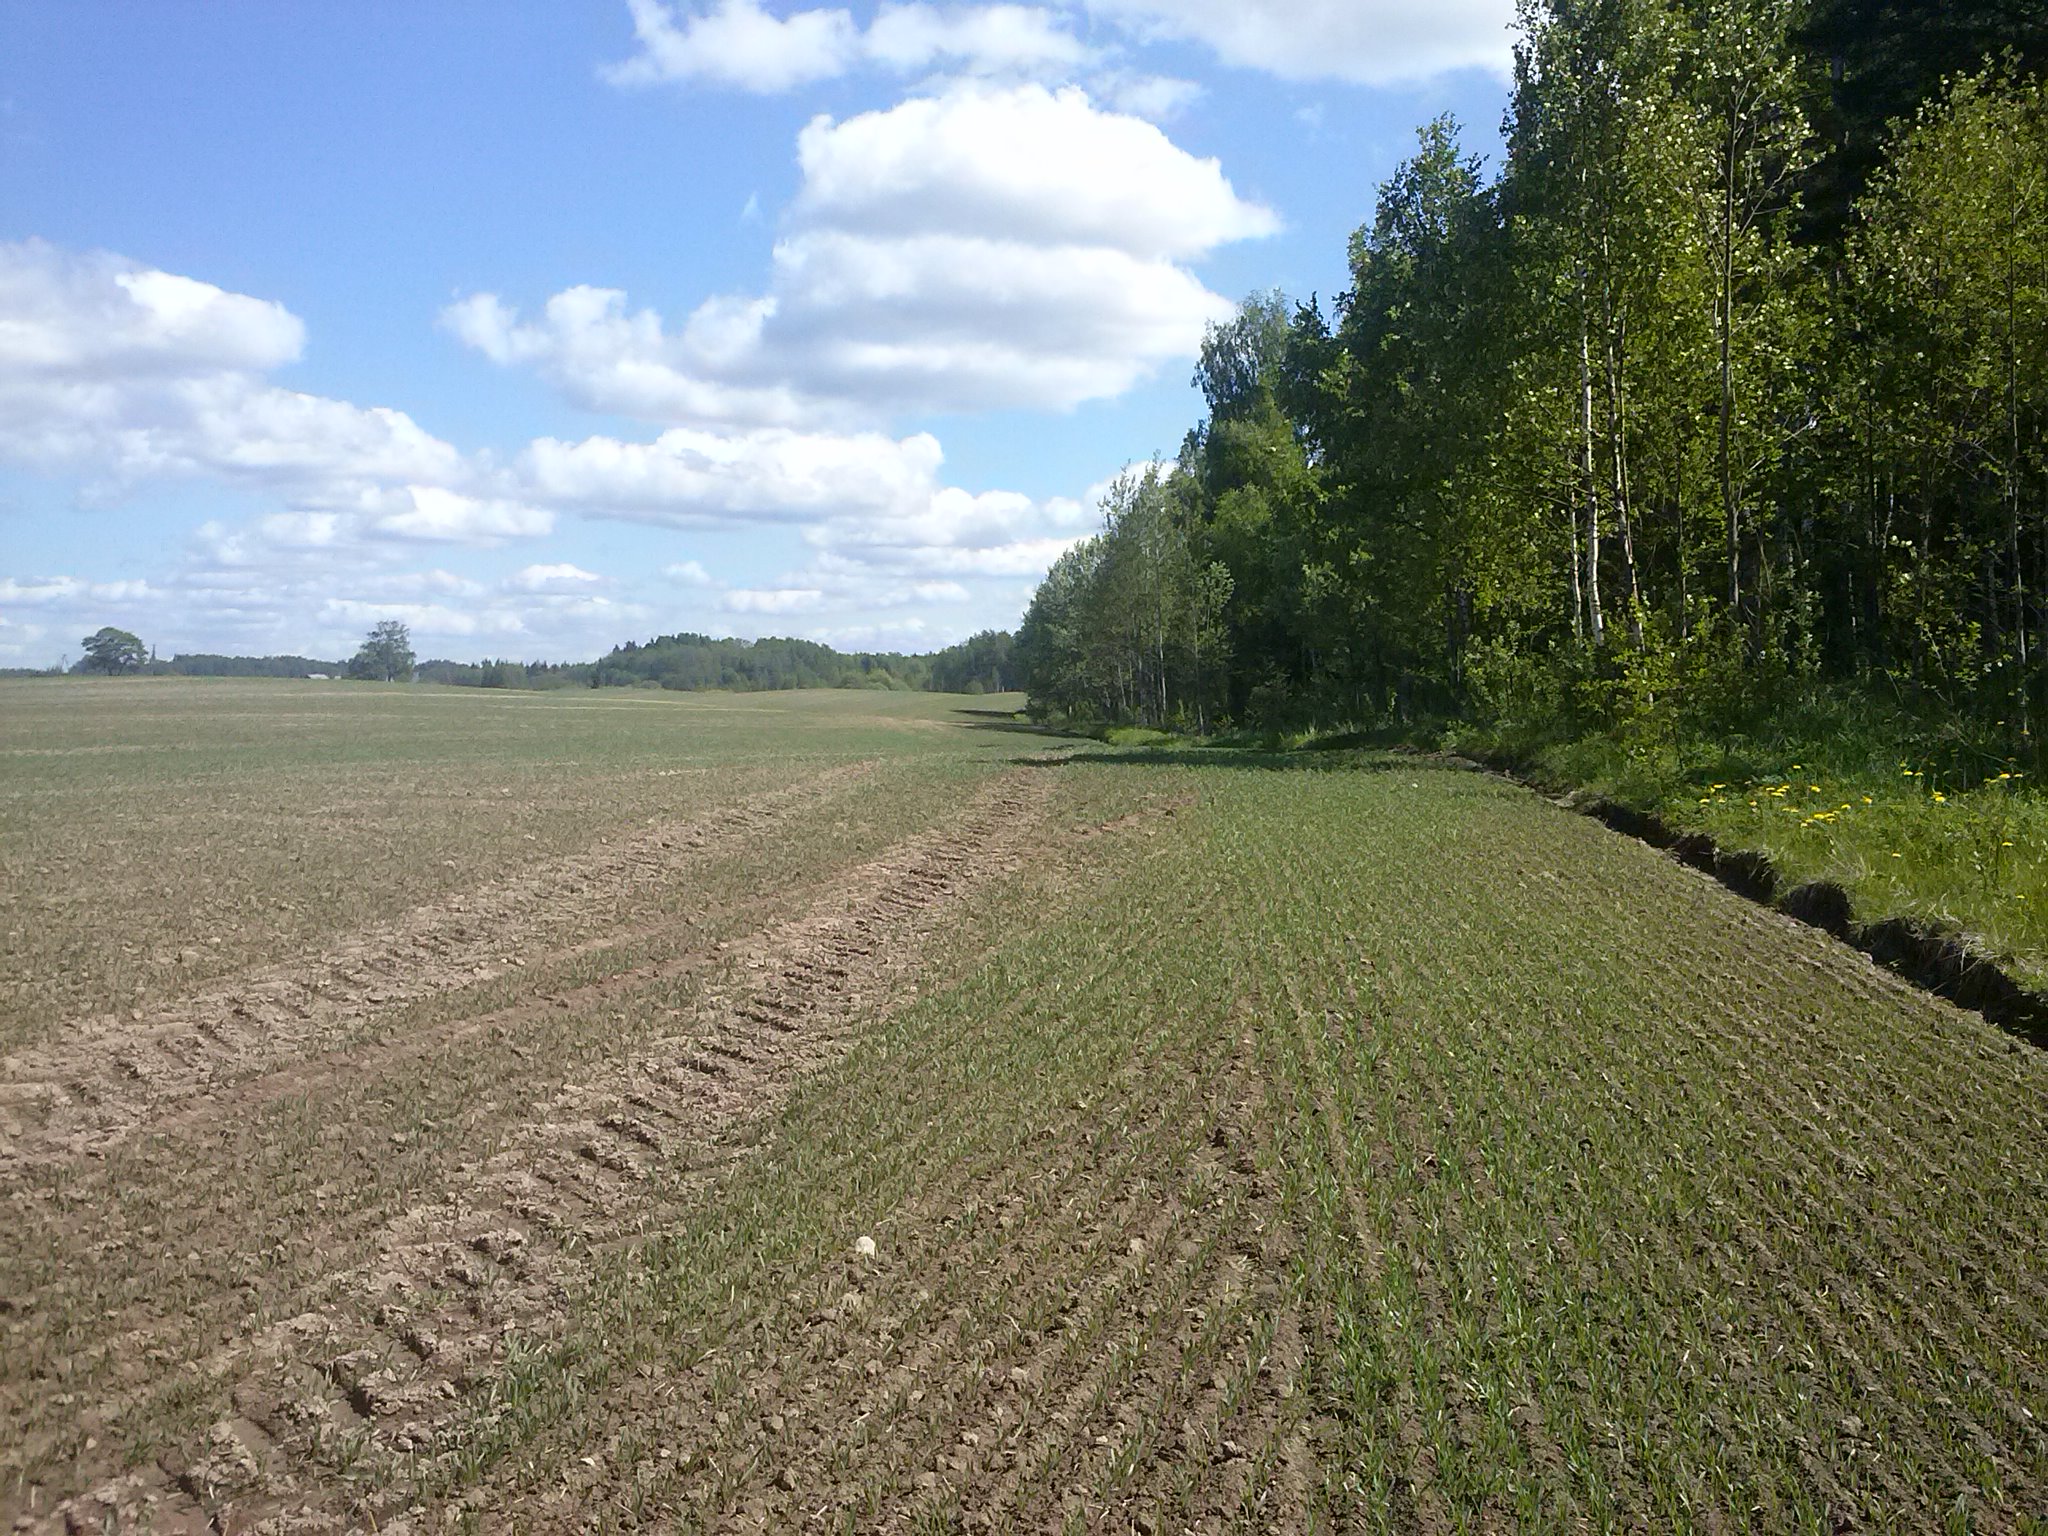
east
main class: Cropland
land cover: Rye
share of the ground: 10 - 25 %
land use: Agriculture (excluding fallow land and kitchen gardens)
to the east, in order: Rye
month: May
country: LV
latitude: 56.1188
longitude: 27.6037
